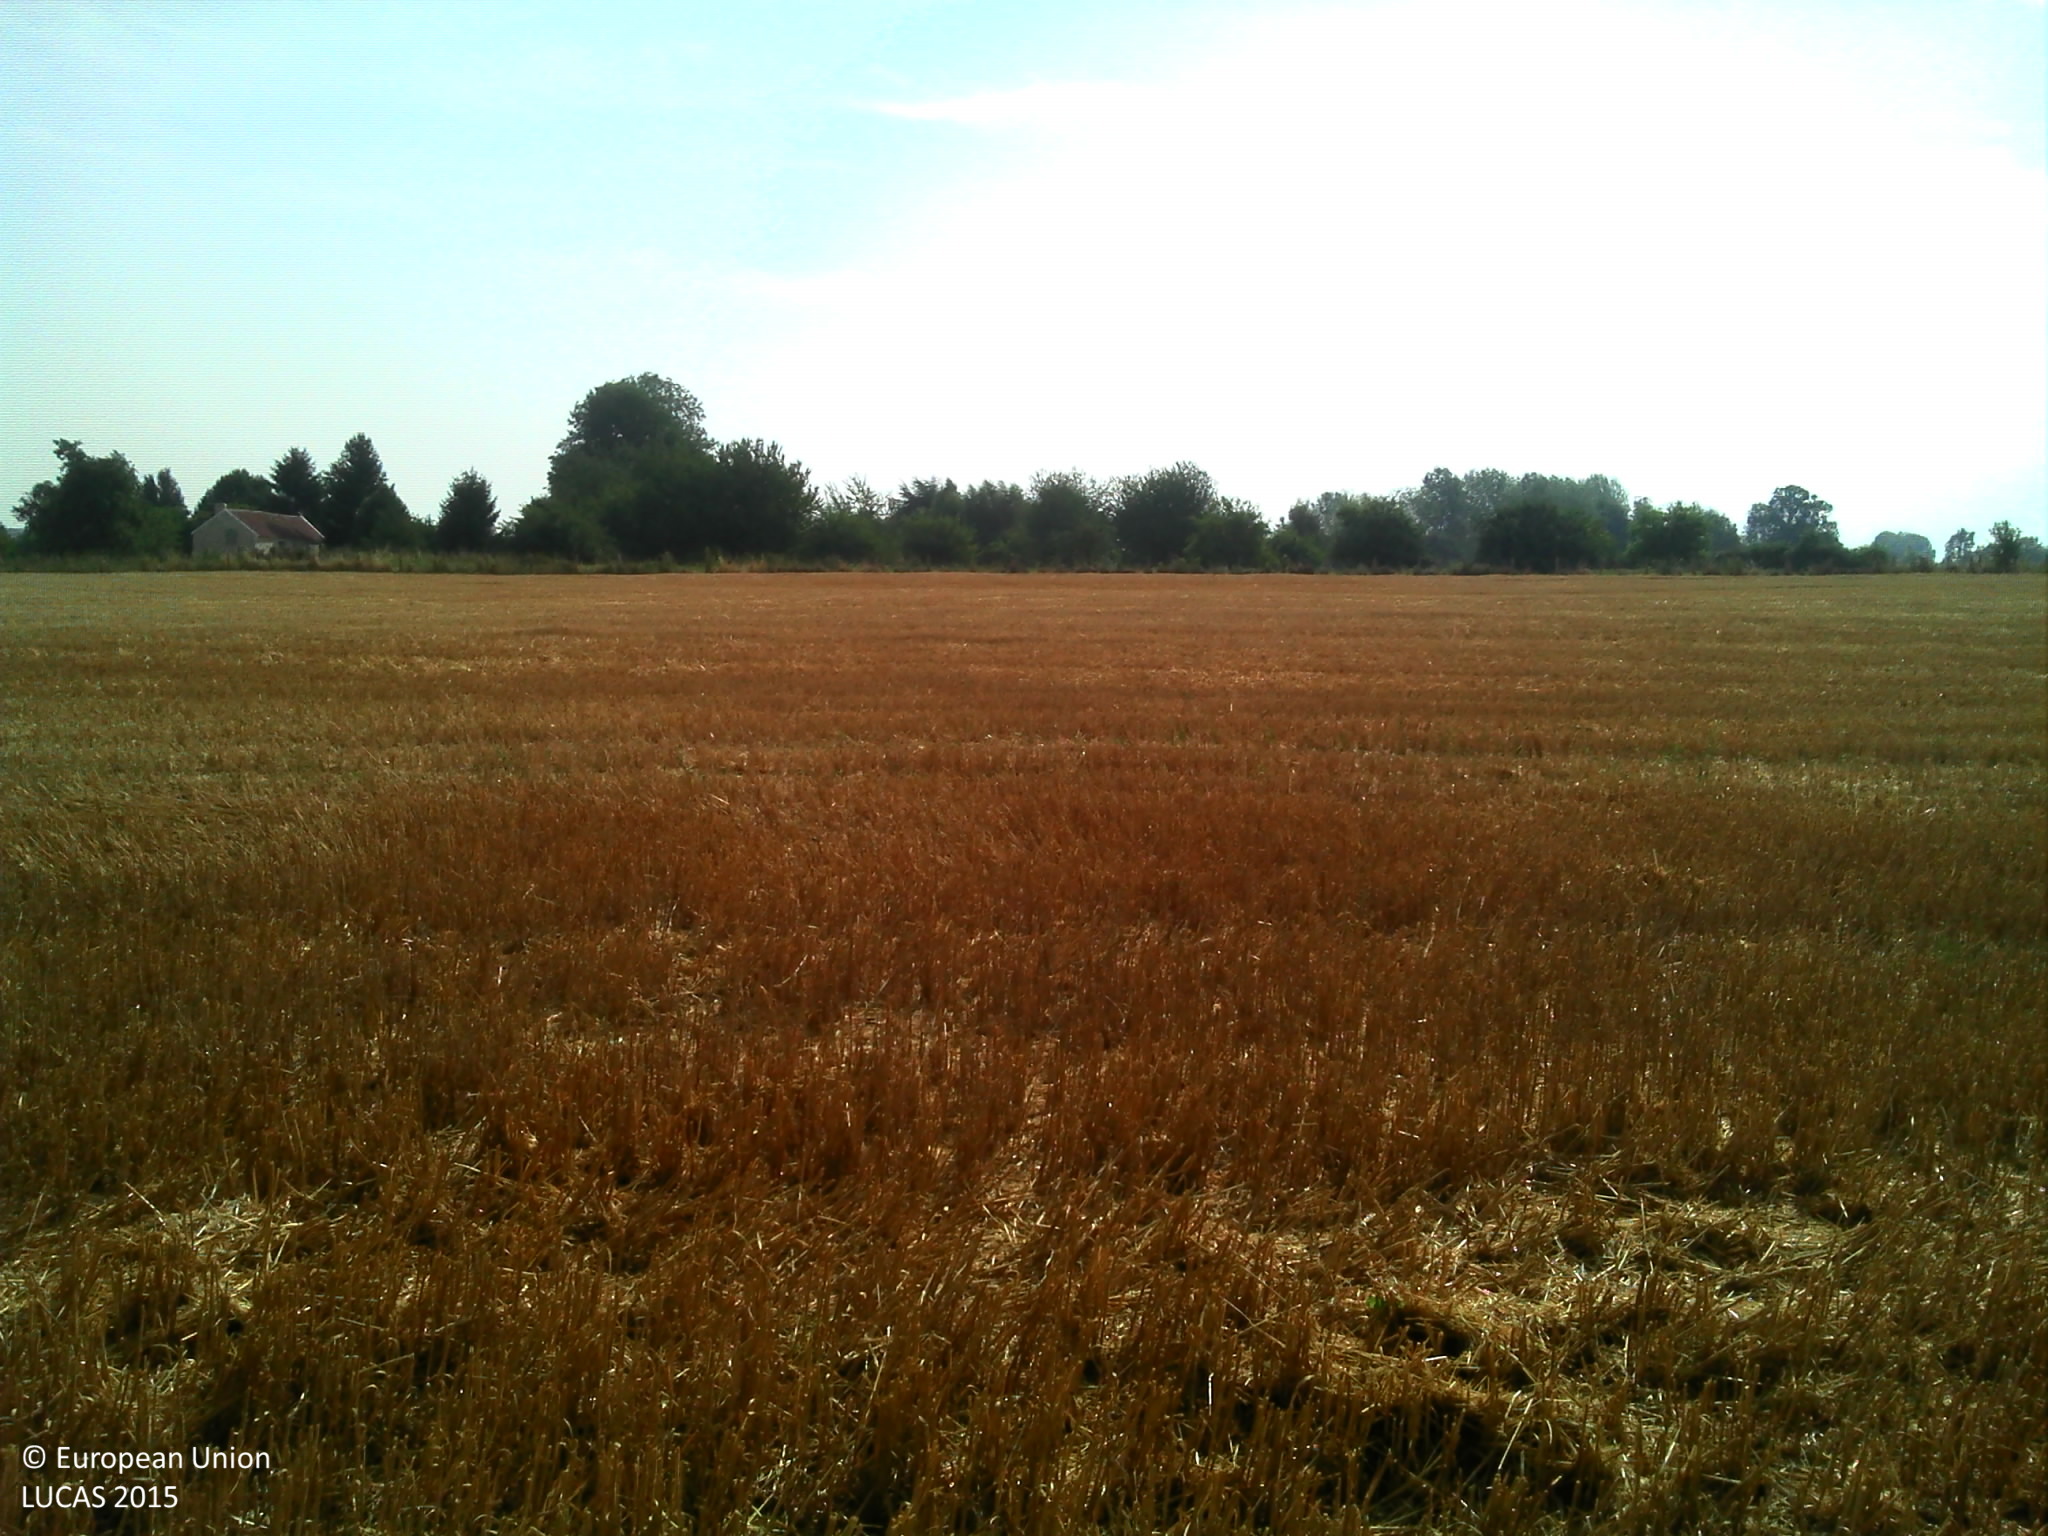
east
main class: Cropland
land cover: Common wheat
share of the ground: > 75 %
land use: Agriculture (excluding fallow land and kitchen gardens)
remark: Harvested field
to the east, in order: Common wheat; Fences; Grassland without tree/shrub cover; Fences; Grassland with sparse tree/shrub cover; Artificial constructions in urban areas
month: August
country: FR
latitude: 48.9179
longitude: 2.9357
